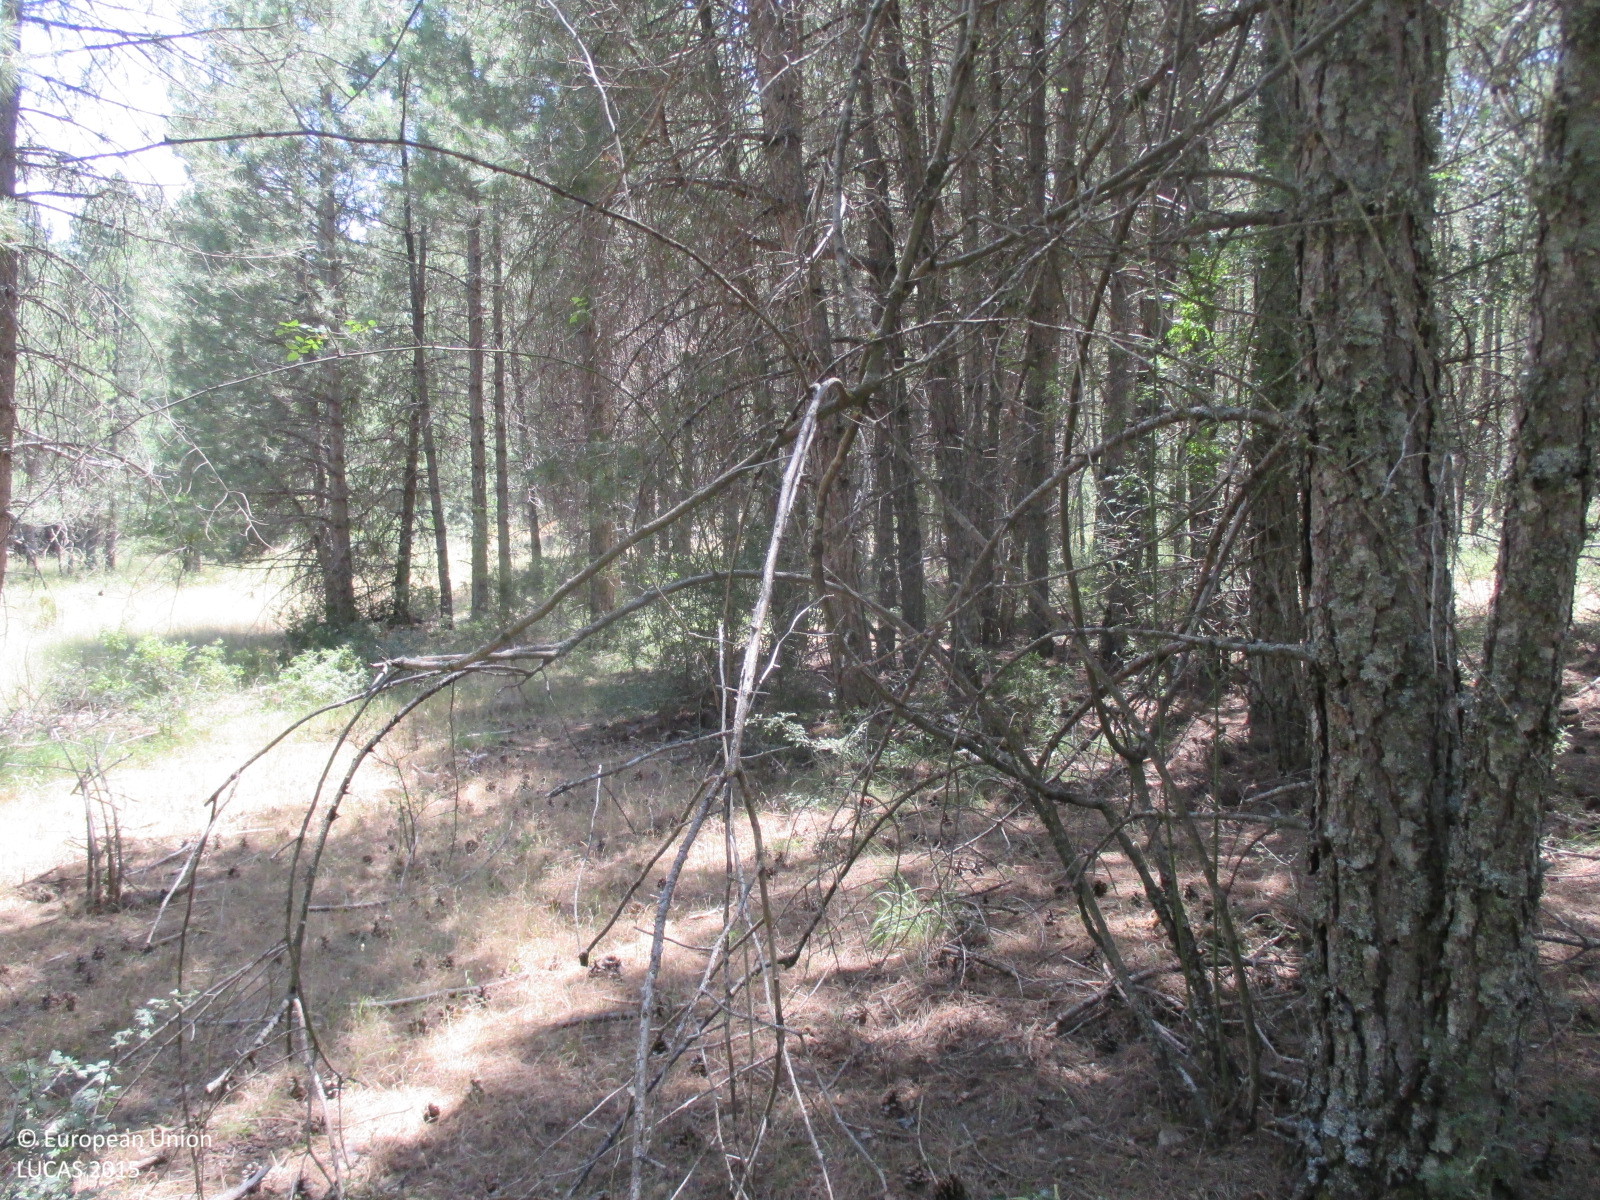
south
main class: Woodland
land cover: Pine dominated coniferous woodland
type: coniferous forest of the mediterranean region
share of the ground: > 75 %
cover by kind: coniferous forest trees 90 %, shrubs 5 %, herbaceous plants 5 %
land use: Forestry
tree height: > 5 m
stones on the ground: < 10 %
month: July
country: ES
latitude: 38.3032
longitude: -2.5643
